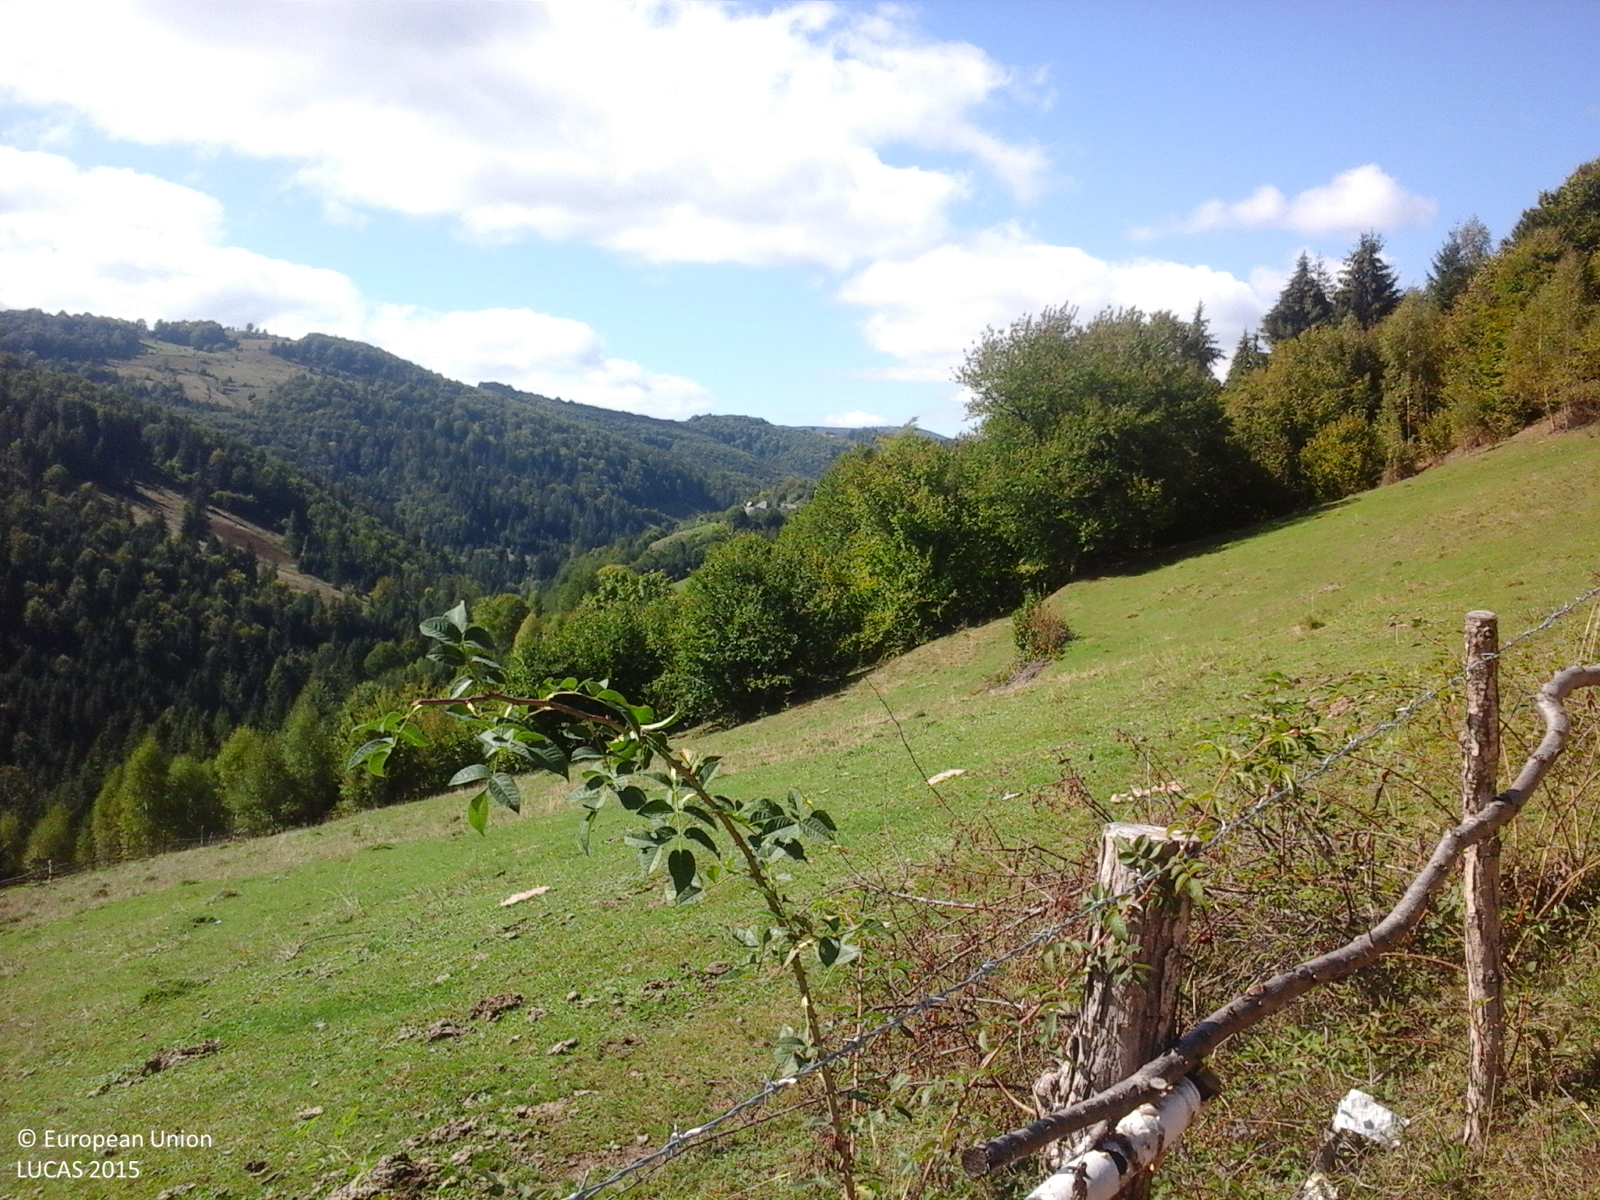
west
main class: Grassland
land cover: Grassland without tree/shrub cover
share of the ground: > 75 %
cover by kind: herbaceous plants 100 %
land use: Agriculture (excluding fallow land and kitchen gardens)
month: October
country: RO
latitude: 46.4230
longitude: 22.8999
